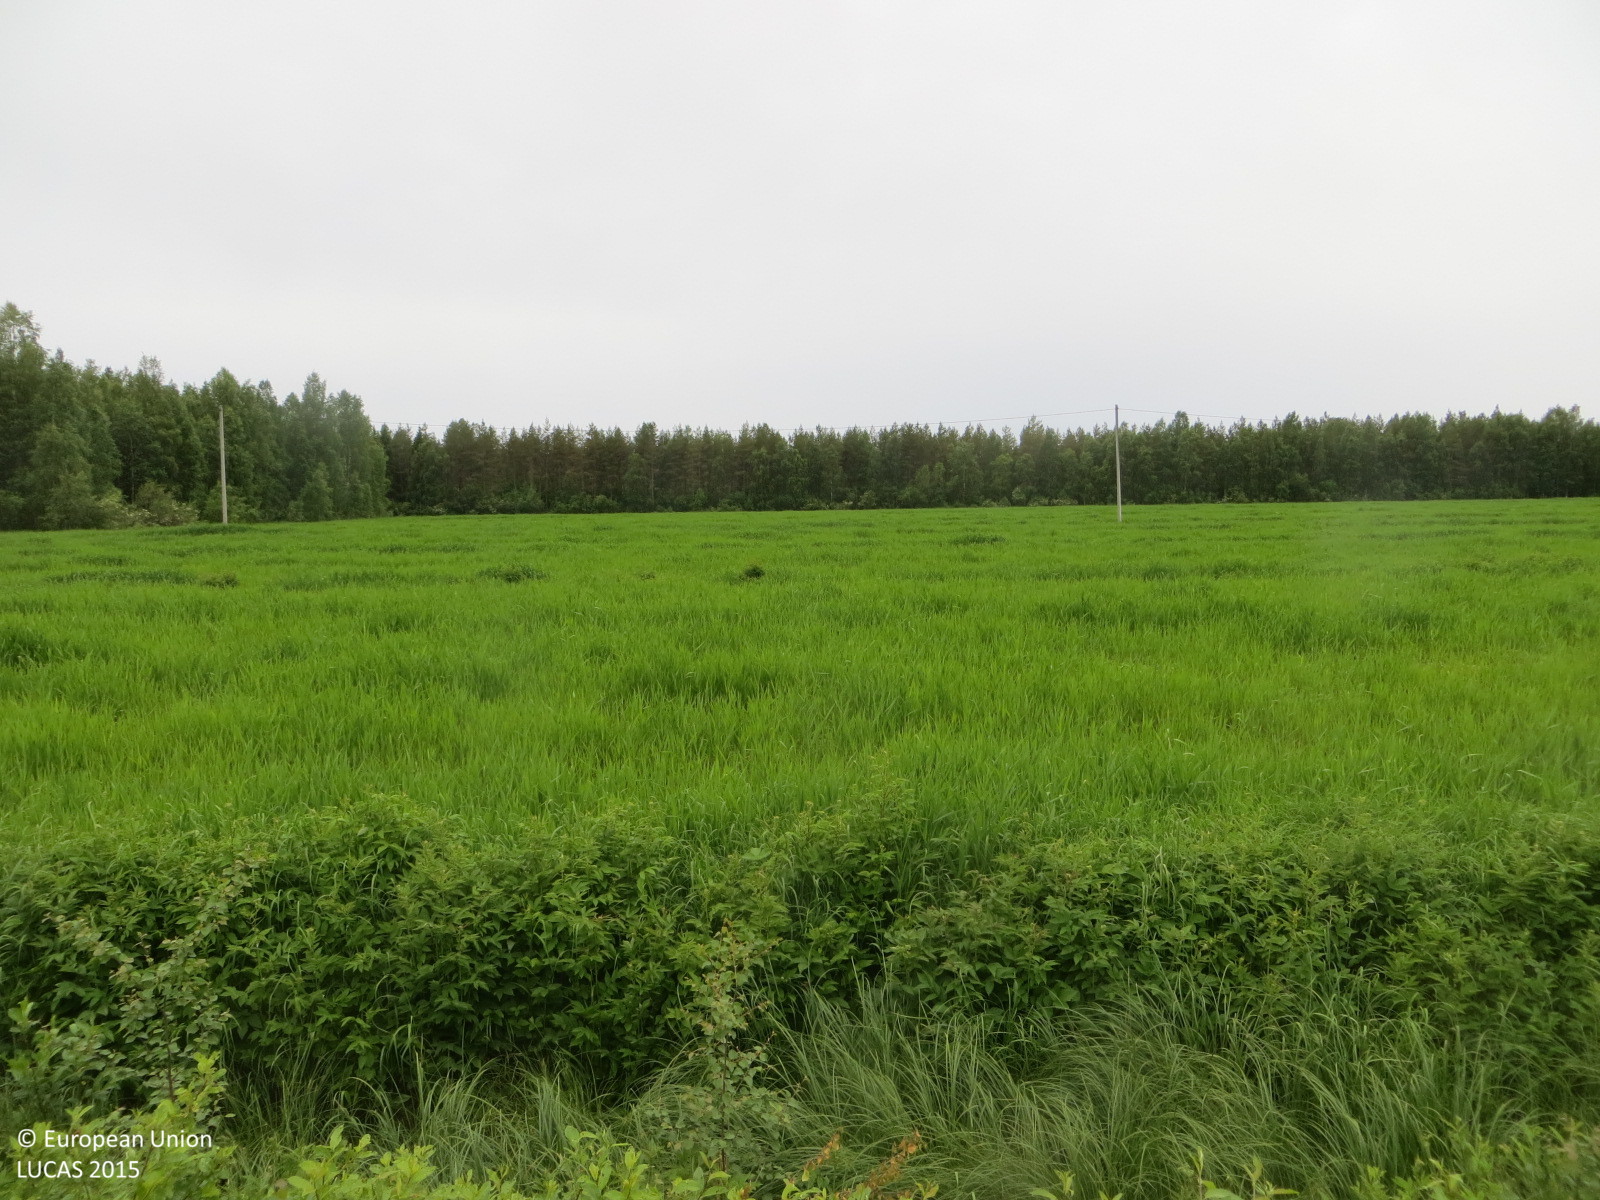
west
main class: Cropland
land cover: Permanent industrial crops
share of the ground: > 75 %
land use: Agriculture (excluding fallow land and kitchen gardens)
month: July
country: FI
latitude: 65.5251
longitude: 25.9878
